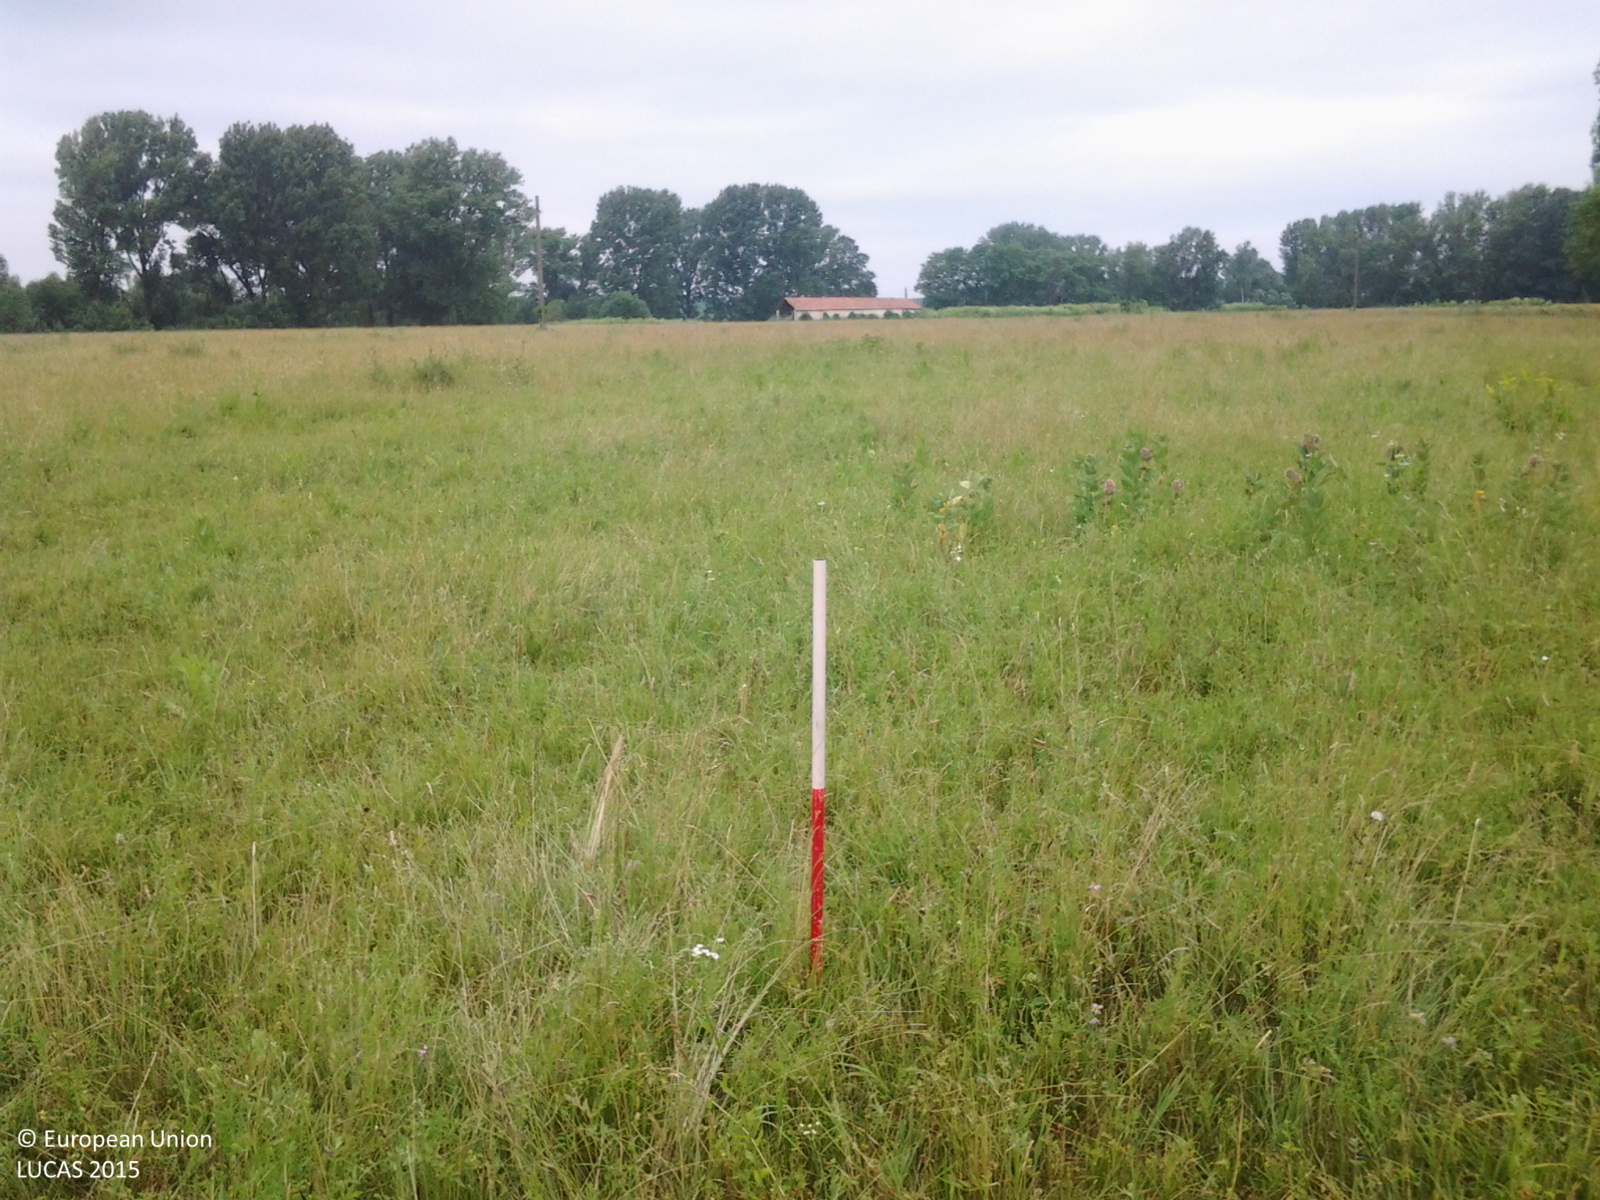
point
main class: Grassland
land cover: Grassland without tree/shrub cover
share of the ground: > 75 %
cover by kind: herbaceous plants 100 %
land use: Agriculture (excluding fallow land and kitchen gardens)
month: June
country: HU
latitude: 46.4819
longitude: 19.1720
